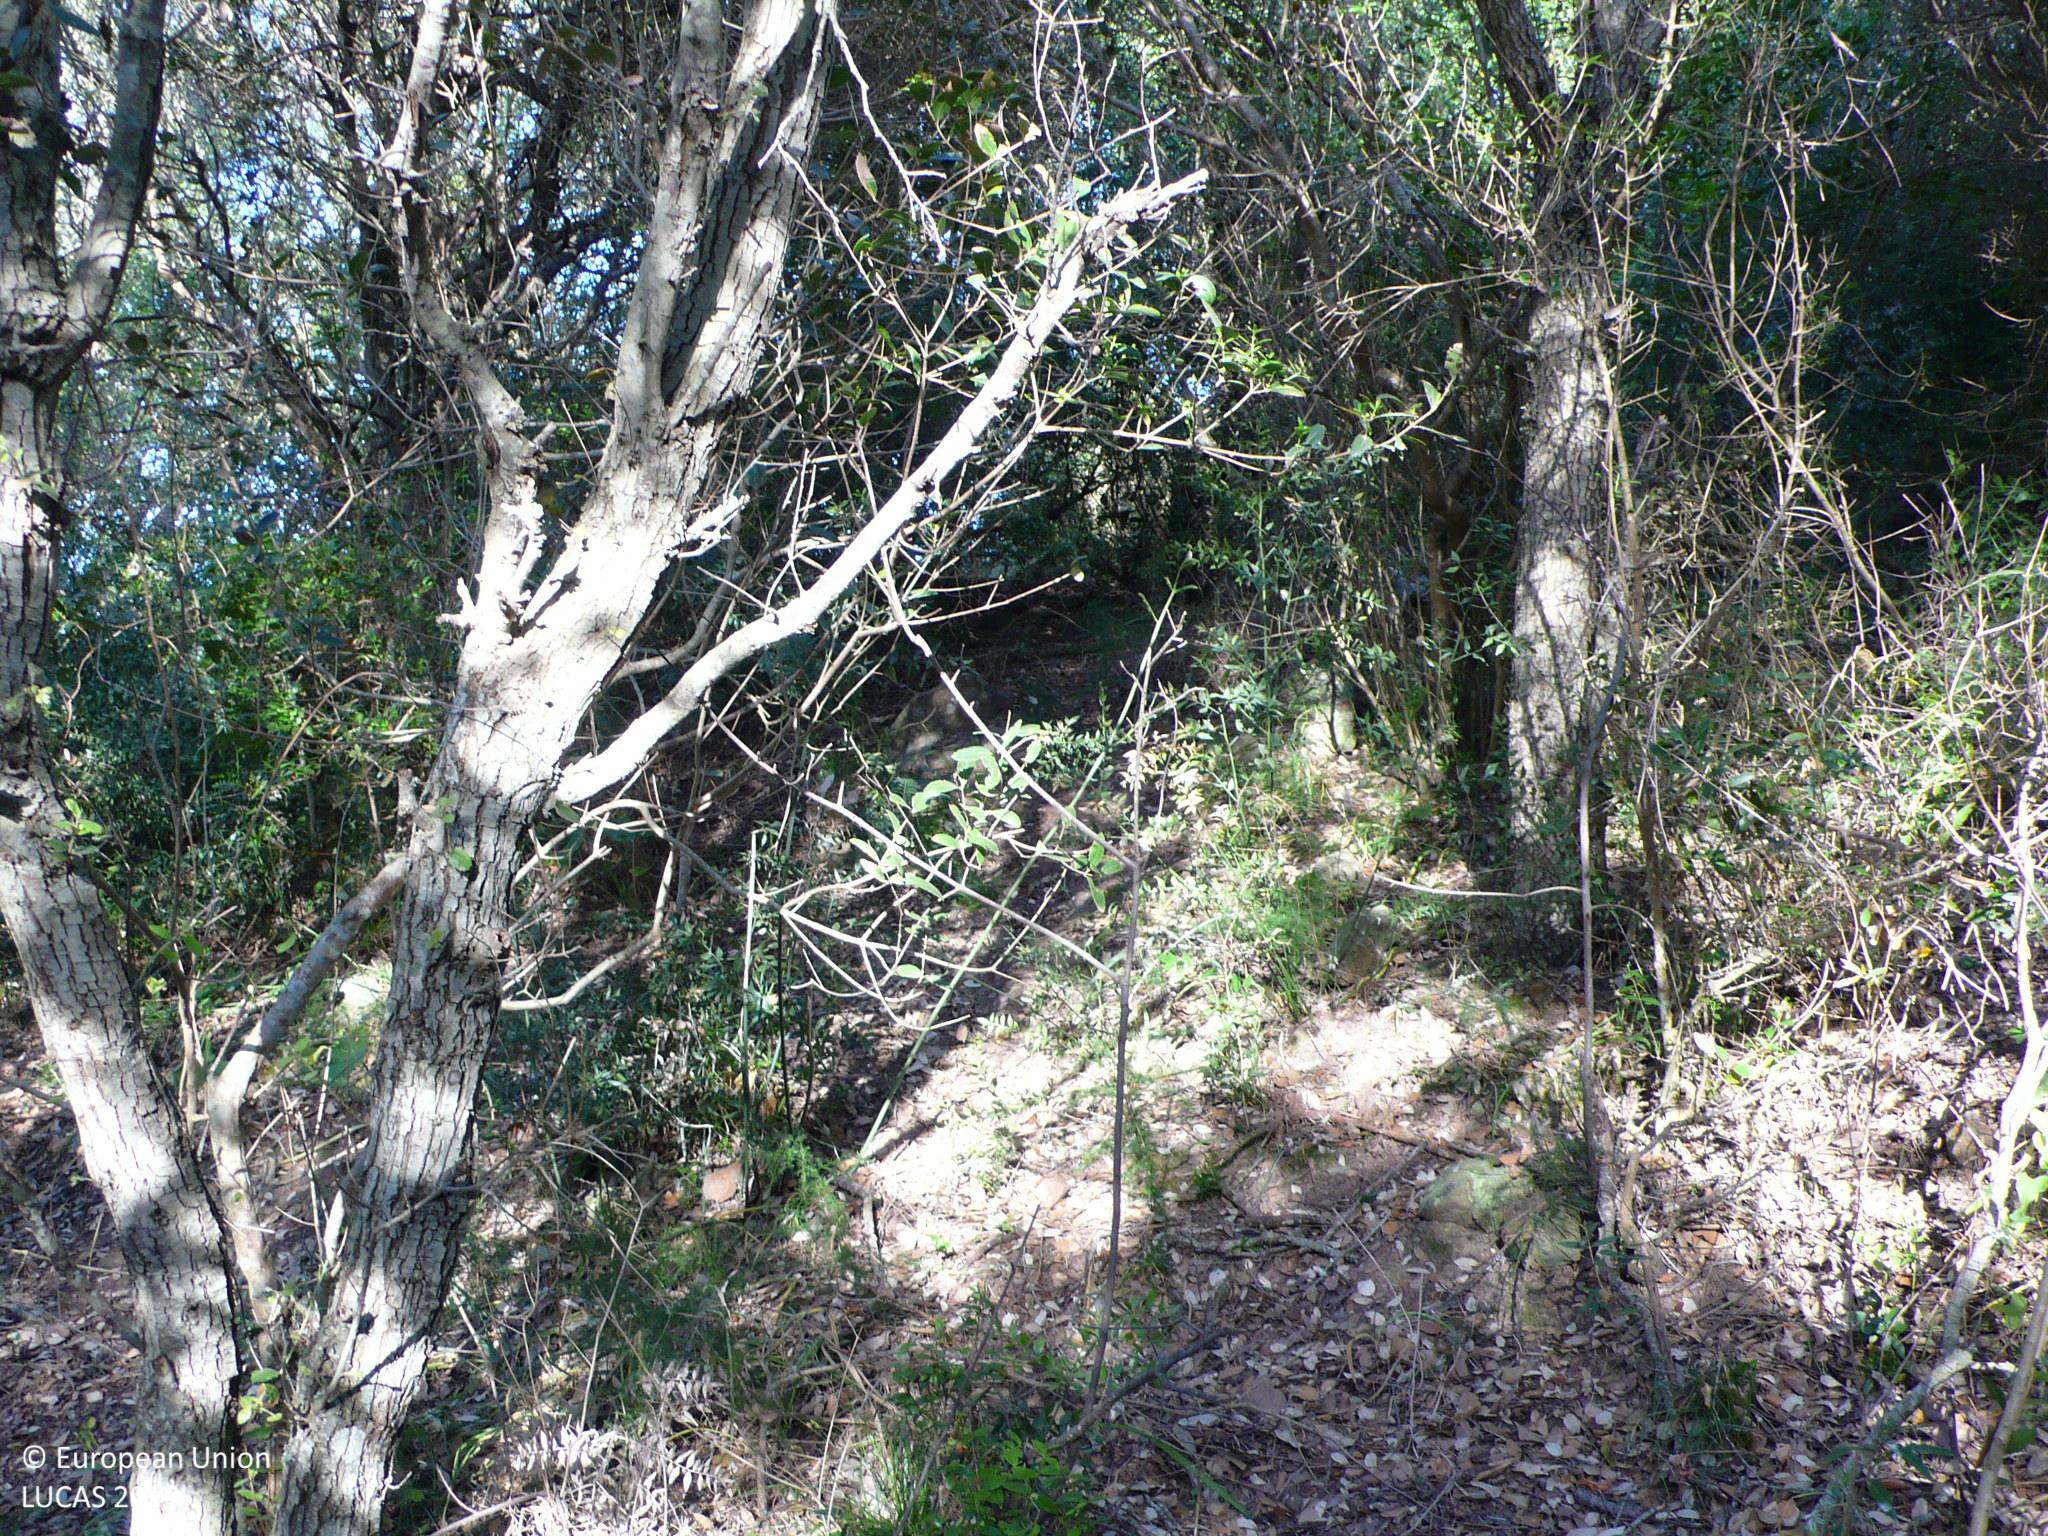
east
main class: Woodland
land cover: Broadleaved woodland
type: thermophilous deciduous forest
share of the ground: > 75 %
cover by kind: broadleaved forest trees 90 %, shrubs 10 %
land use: Semi-natural and natural areas not in use
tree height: > 5 m
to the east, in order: Broadleaved woodland; Mixed cereals for fodder; Broadleaved woodland; Dry stone walls; Oats; Shruby margins; Dry stone walls; Shruby margins; Oats; Tracks; Oats
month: May
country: ES
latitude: 39.9982
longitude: 4.0874
